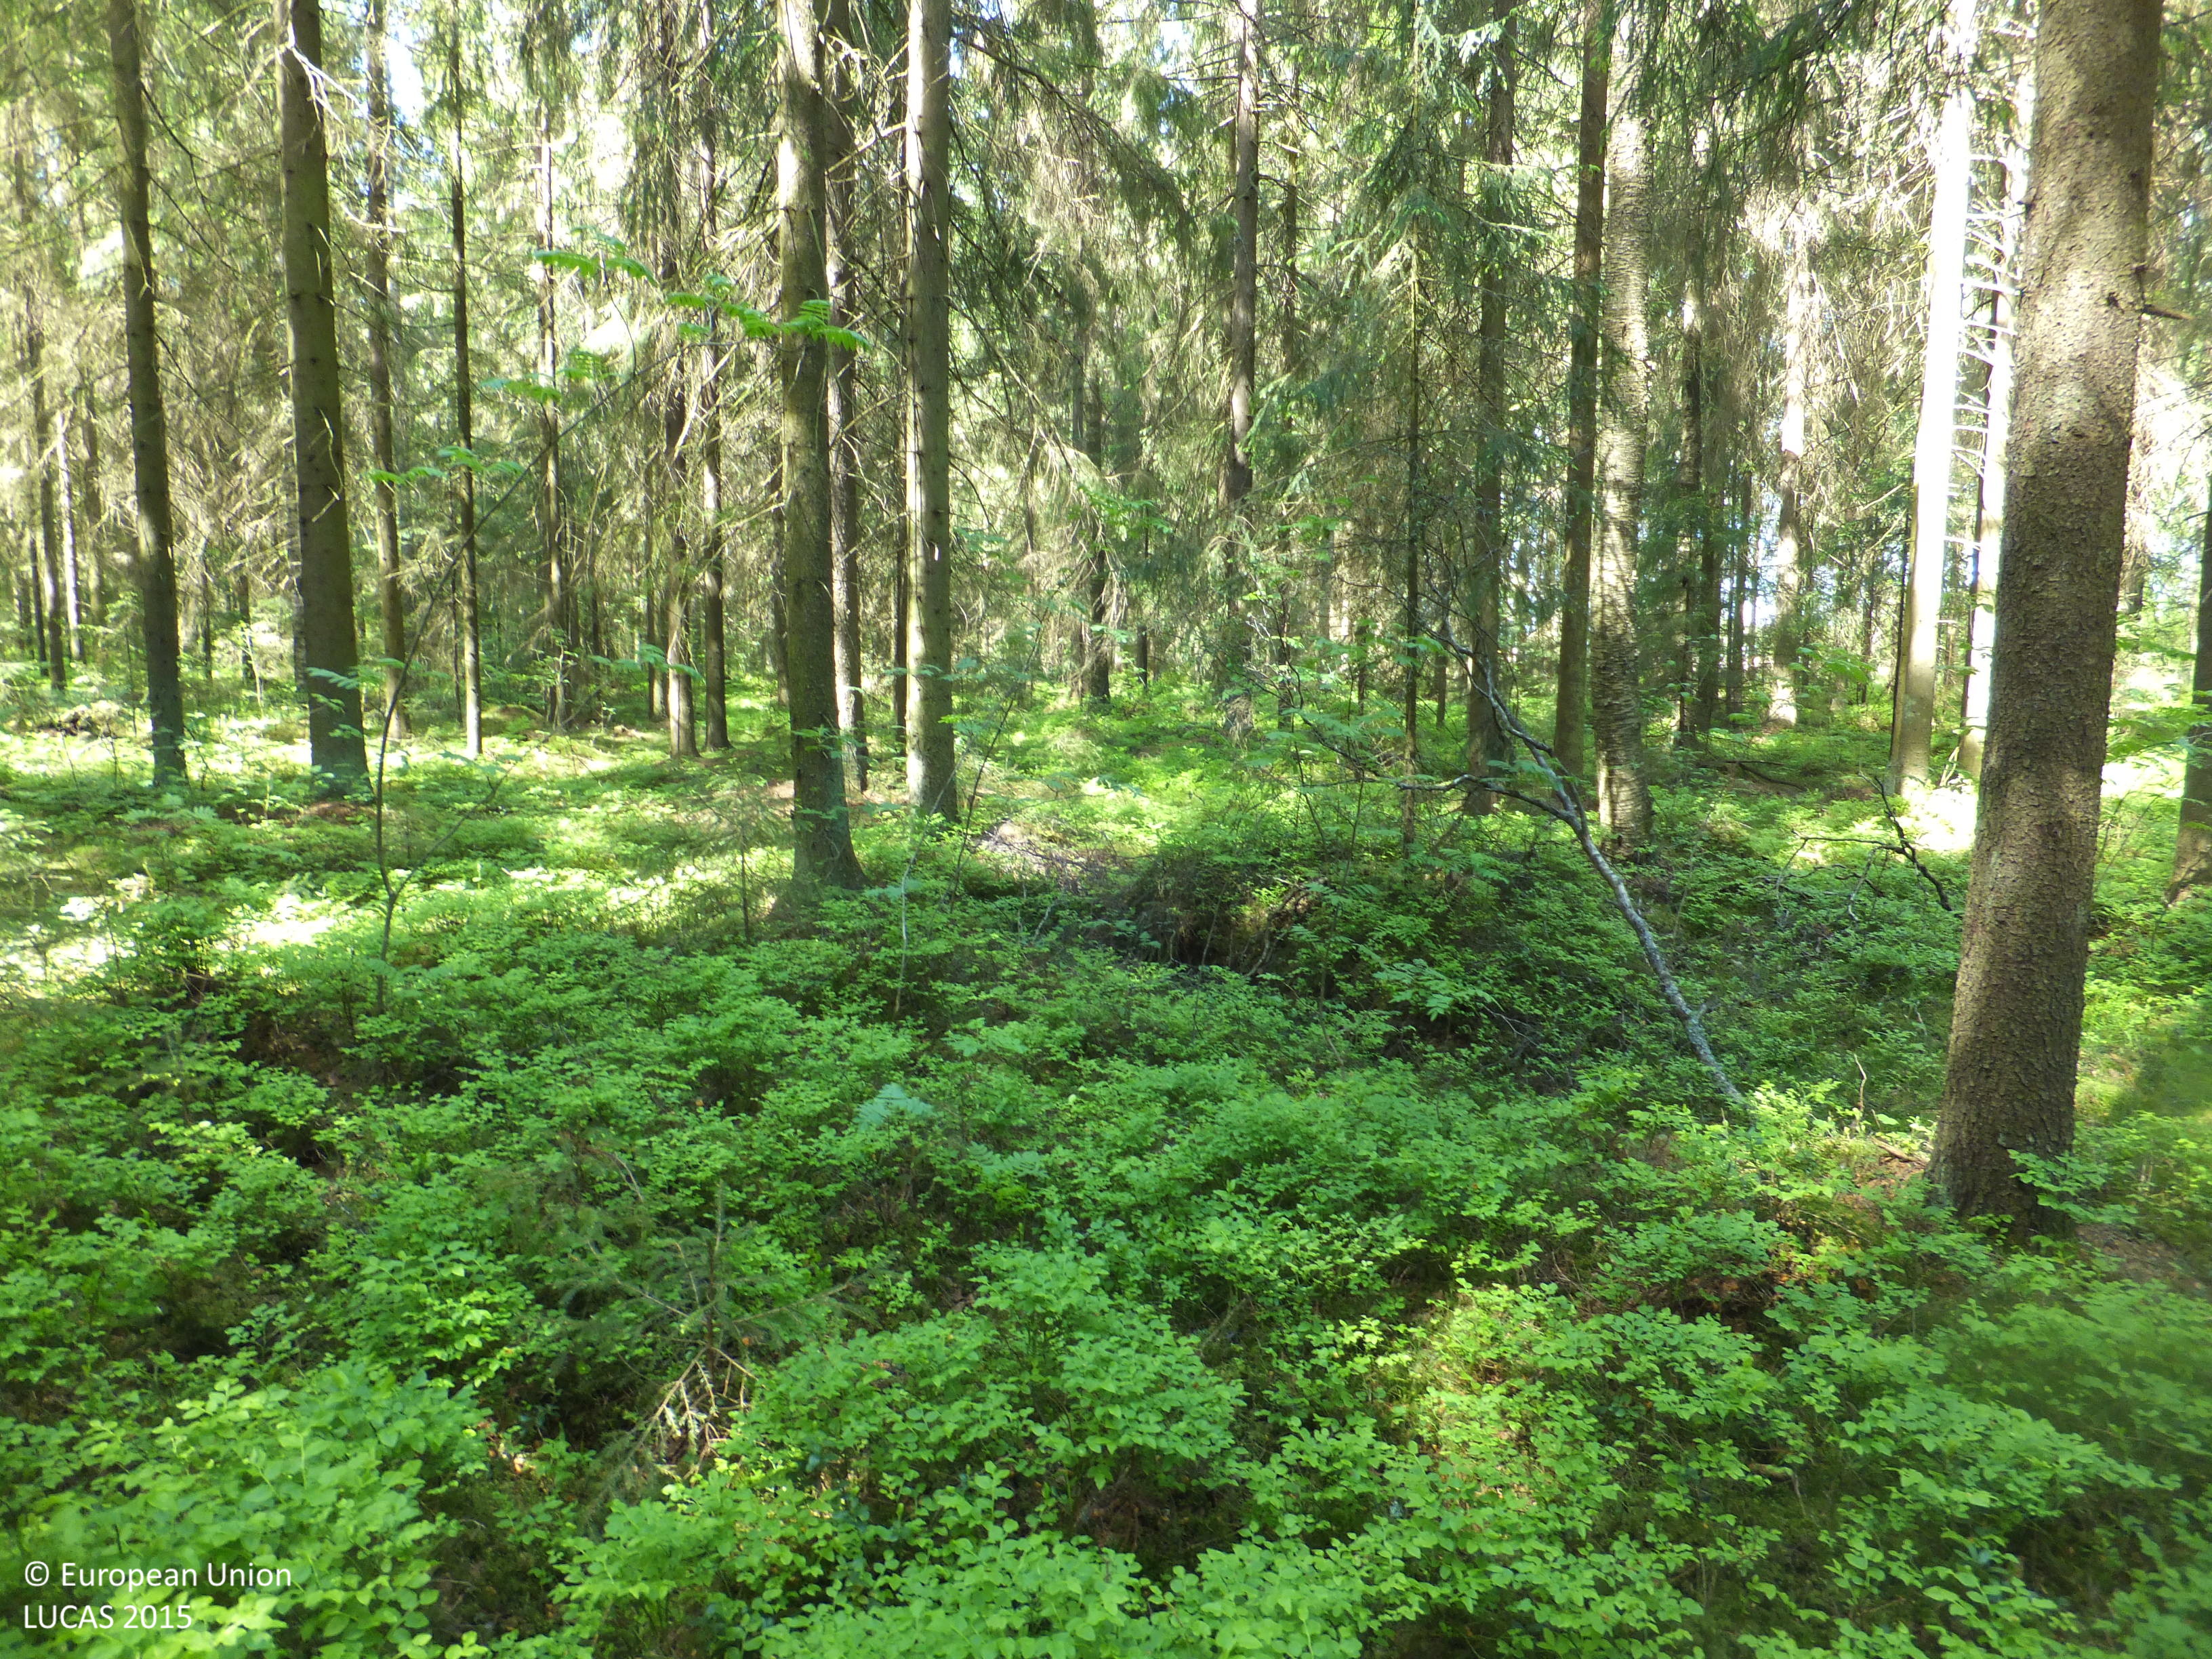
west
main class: Woodland
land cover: Spruce dominated coniferous woodland
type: boreal forest
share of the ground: > 75 %
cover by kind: coniferous forest trees 95 %, shrubs 5 %
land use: Forestry
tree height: > 5 m
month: June
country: FI
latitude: 63.3458
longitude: 22.5772
